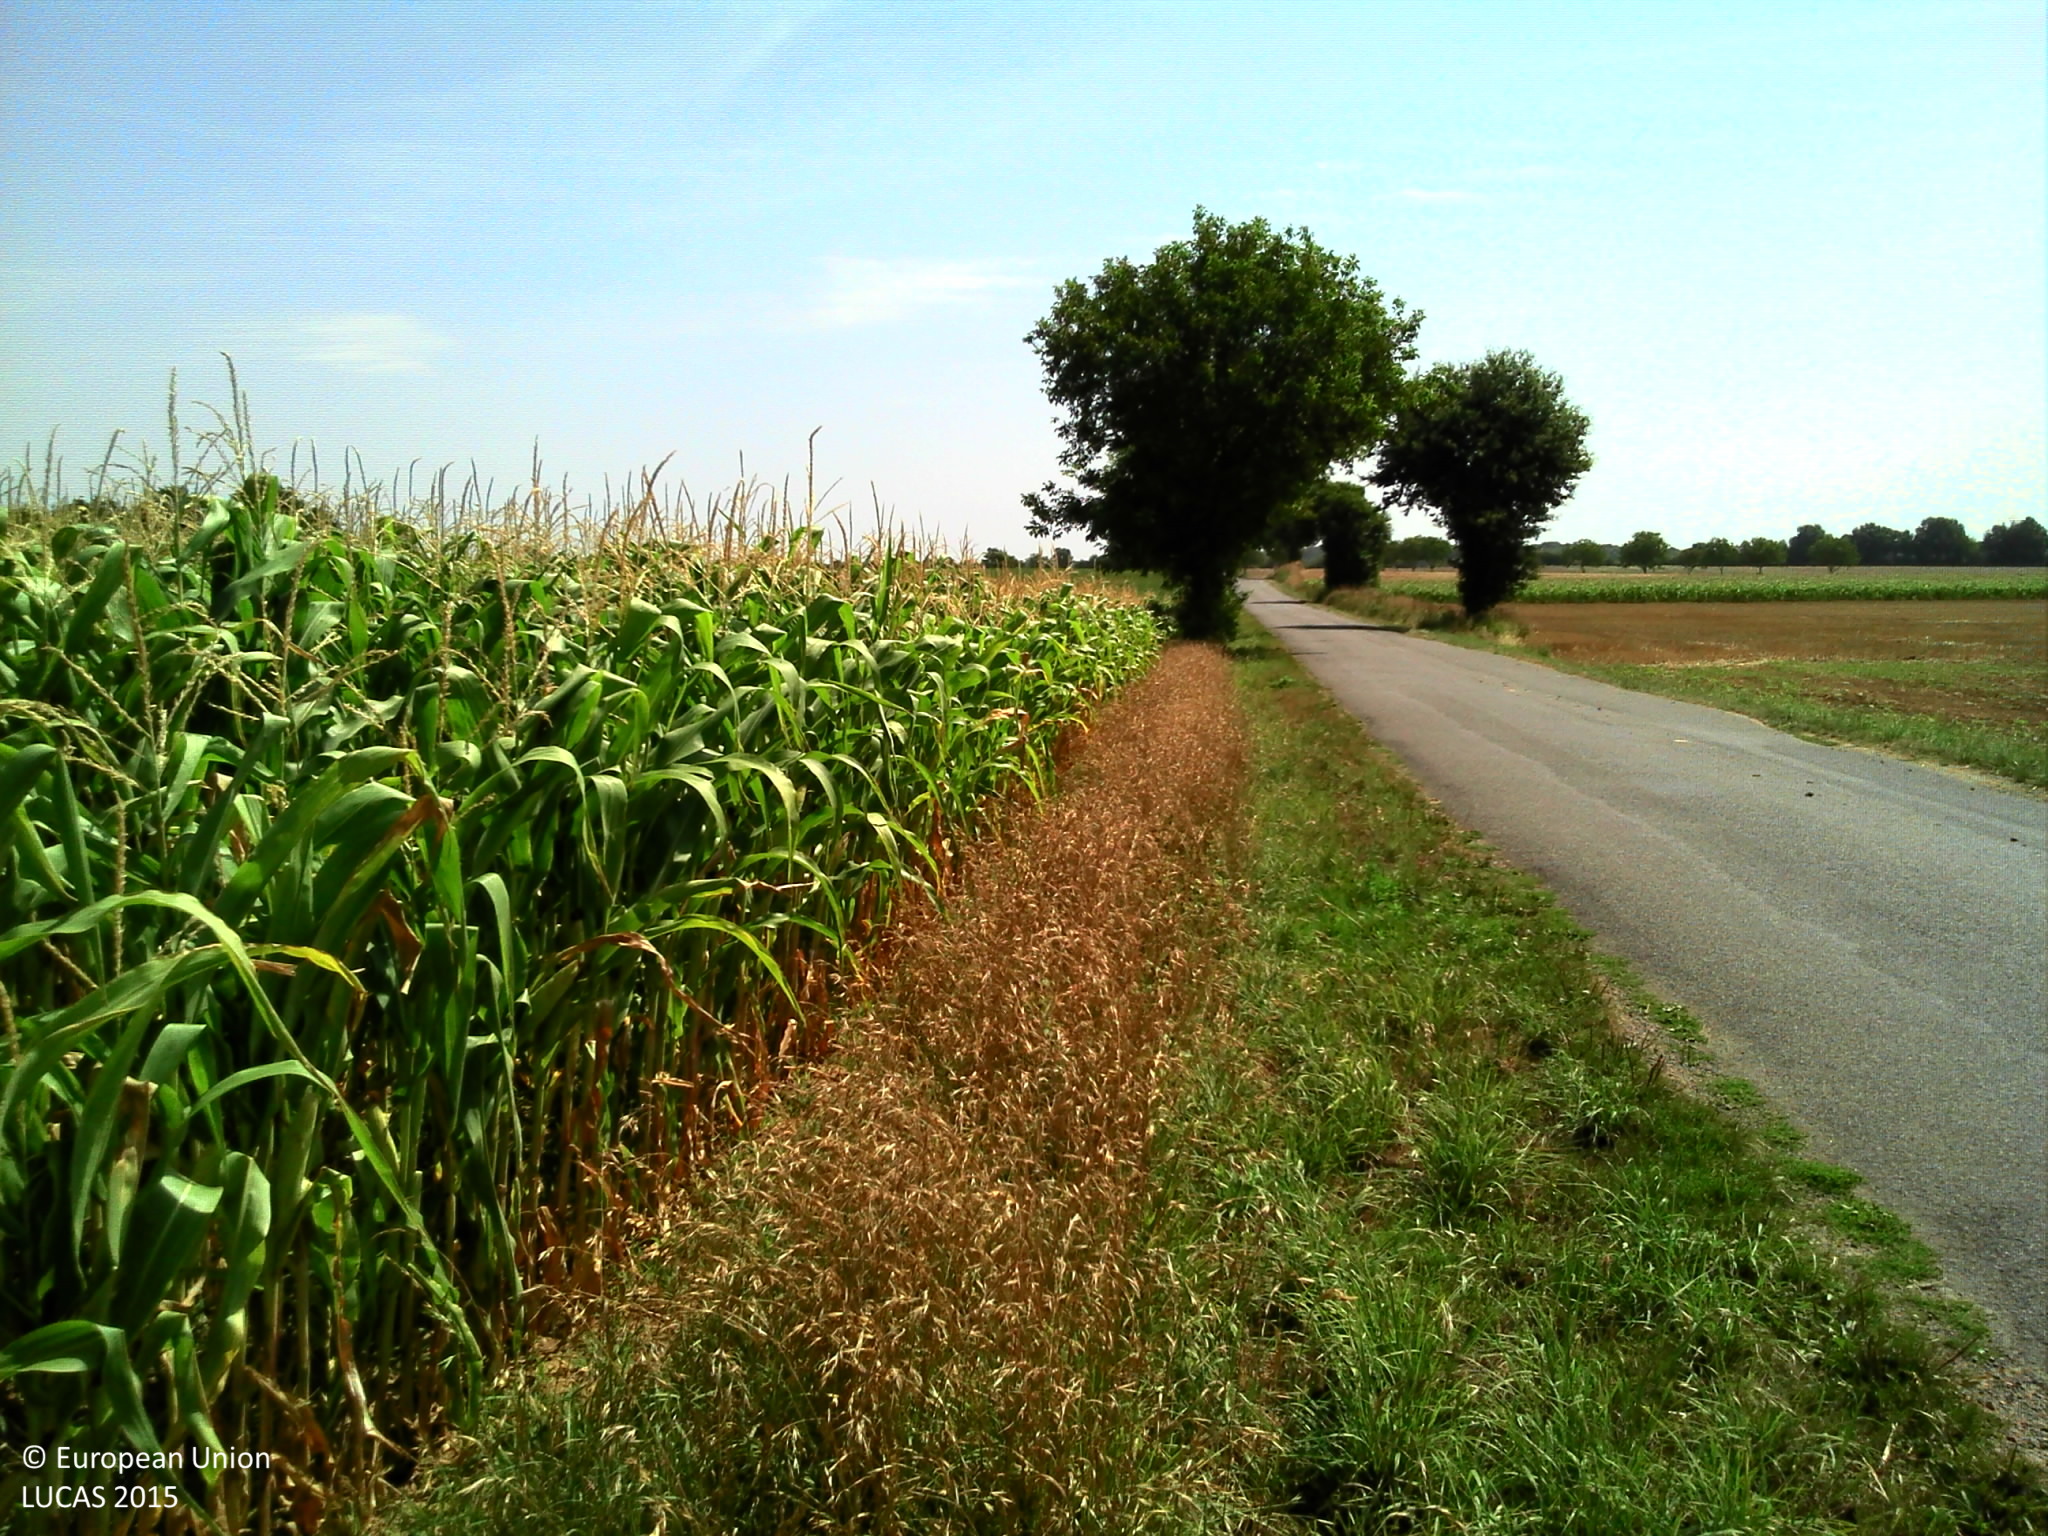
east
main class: Cropland
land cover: Maize
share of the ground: > 75 %
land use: Agriculture (excluding fallow land and kitchen gardens)
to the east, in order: Maize; Soya
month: August
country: FR
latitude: 46.2176
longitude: 0.2985
